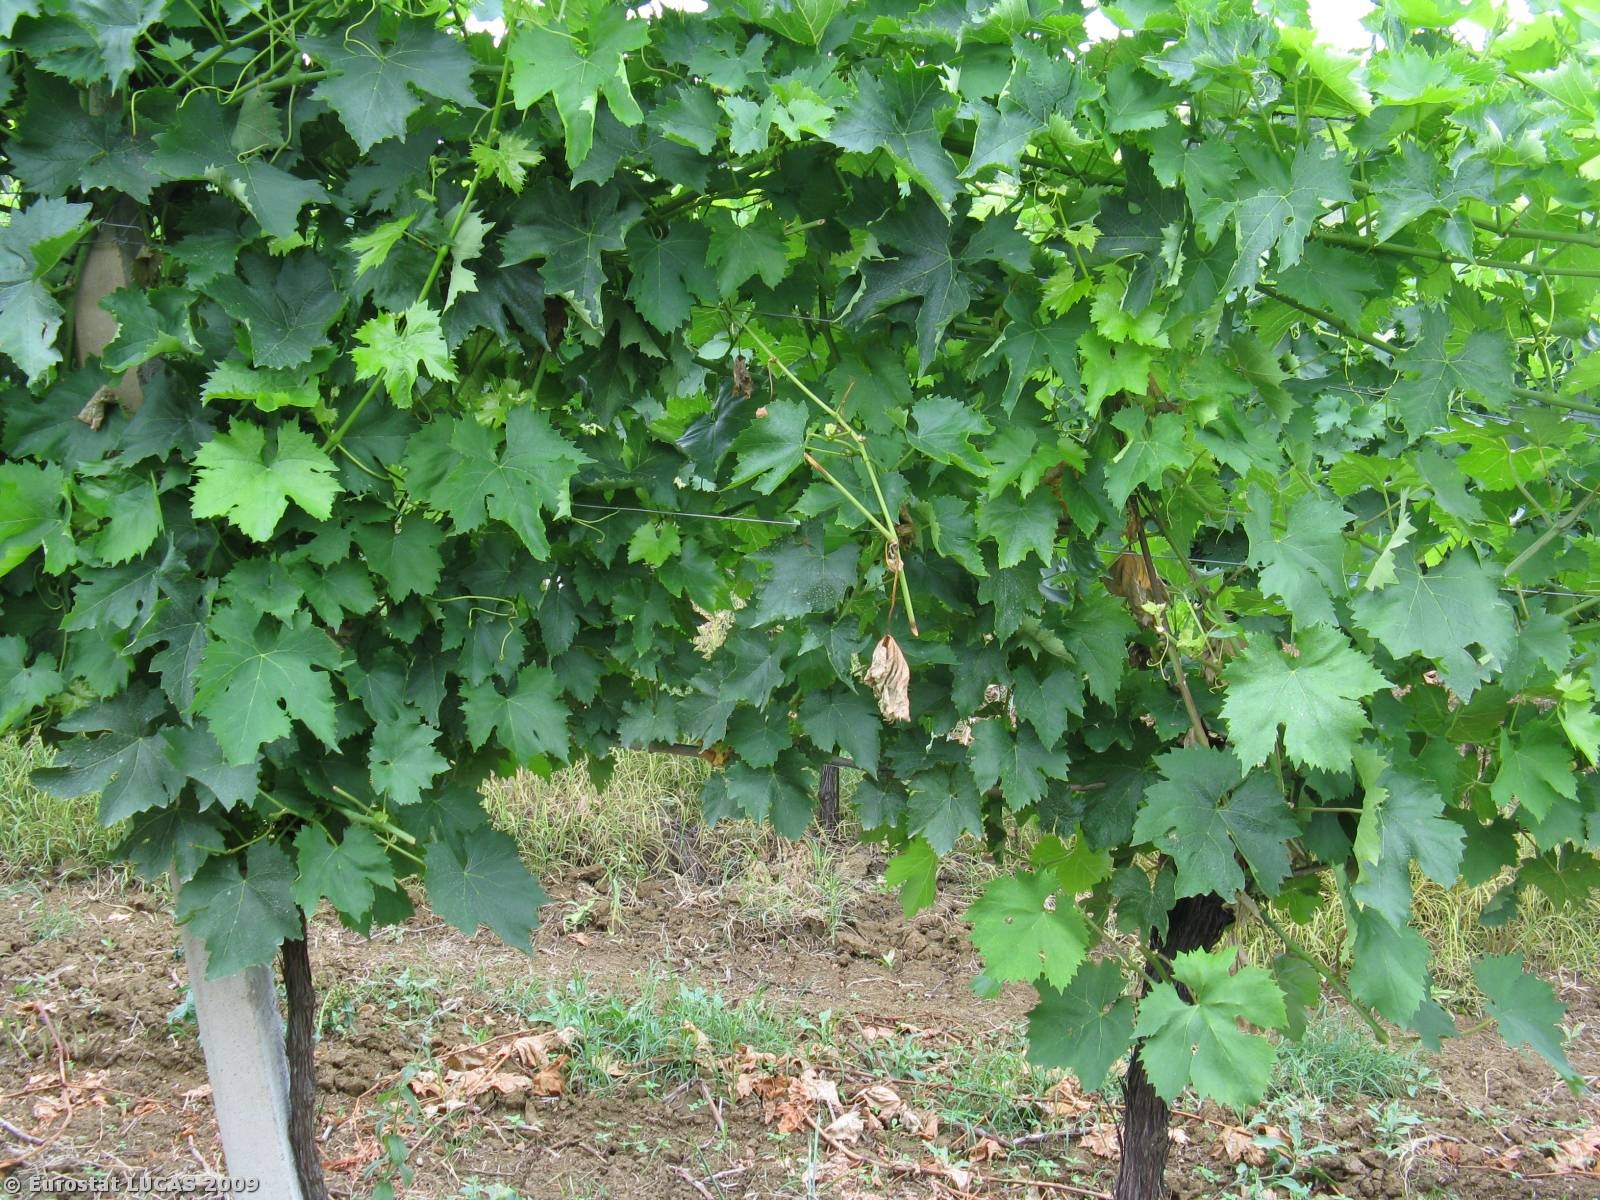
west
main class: Cropland
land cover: Vineyards
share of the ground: 25 - 50 %
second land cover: Bare land
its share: > 75 %
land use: Agriculture (excluding fallow land and kitchen gardens)
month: June
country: IT
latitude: 44.3184
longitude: 11.7139
